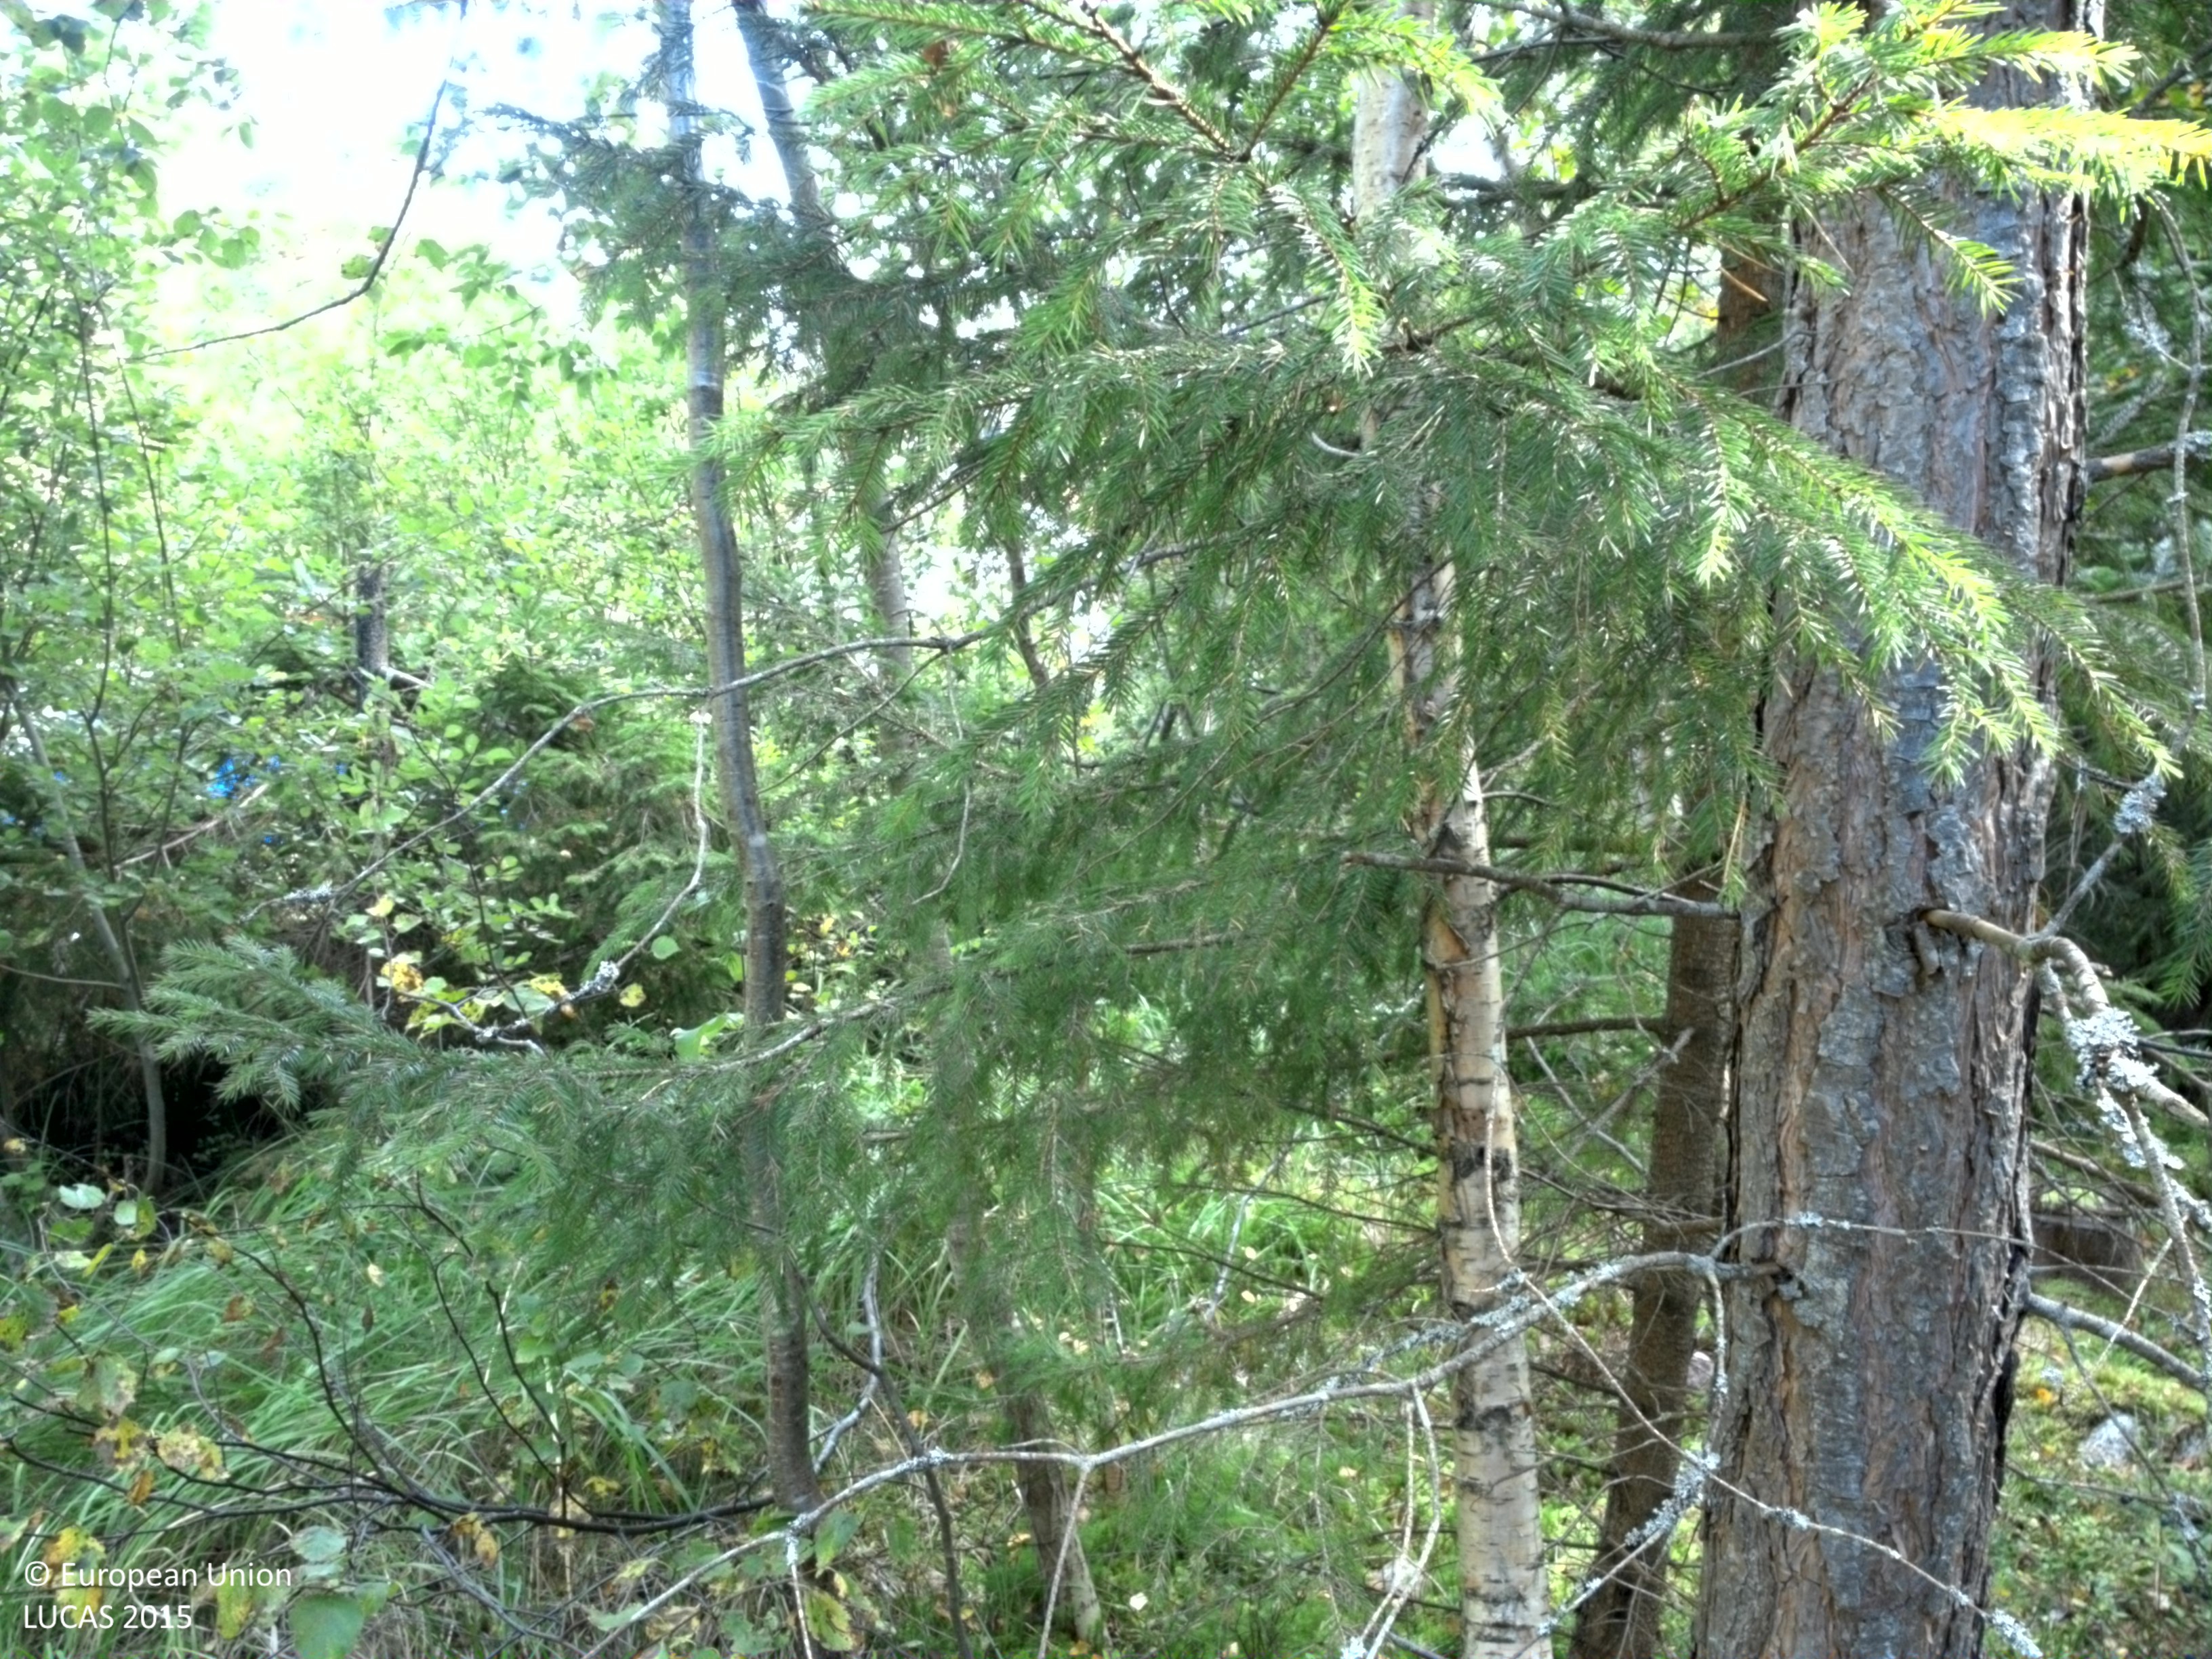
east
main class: Woodland
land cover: Spruce dominated coniferous woodland
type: boreal forest
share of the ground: 50 - 75 %
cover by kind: coniferous forest trees 60 %, broadleaved forest trees 15 %, shrubs 15 %, lichens and mosses 10 %
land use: Forestry
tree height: > 5 m
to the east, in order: Spruce dominated coniferous woodland; Artificial constructions in urban areas; Pine dominated coniferous woodland; Artificial constructions in urban areas; Spruce dominated coniferous woodland; Artificial constructions in urban areas; Spruce dominated coniferous woodland; Paved roads, cycling and walking lanes; Spruce dominated coniferous woodland; Artificial constructions in urban areas
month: September
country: SE
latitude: 59.2754
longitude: 18.4414
